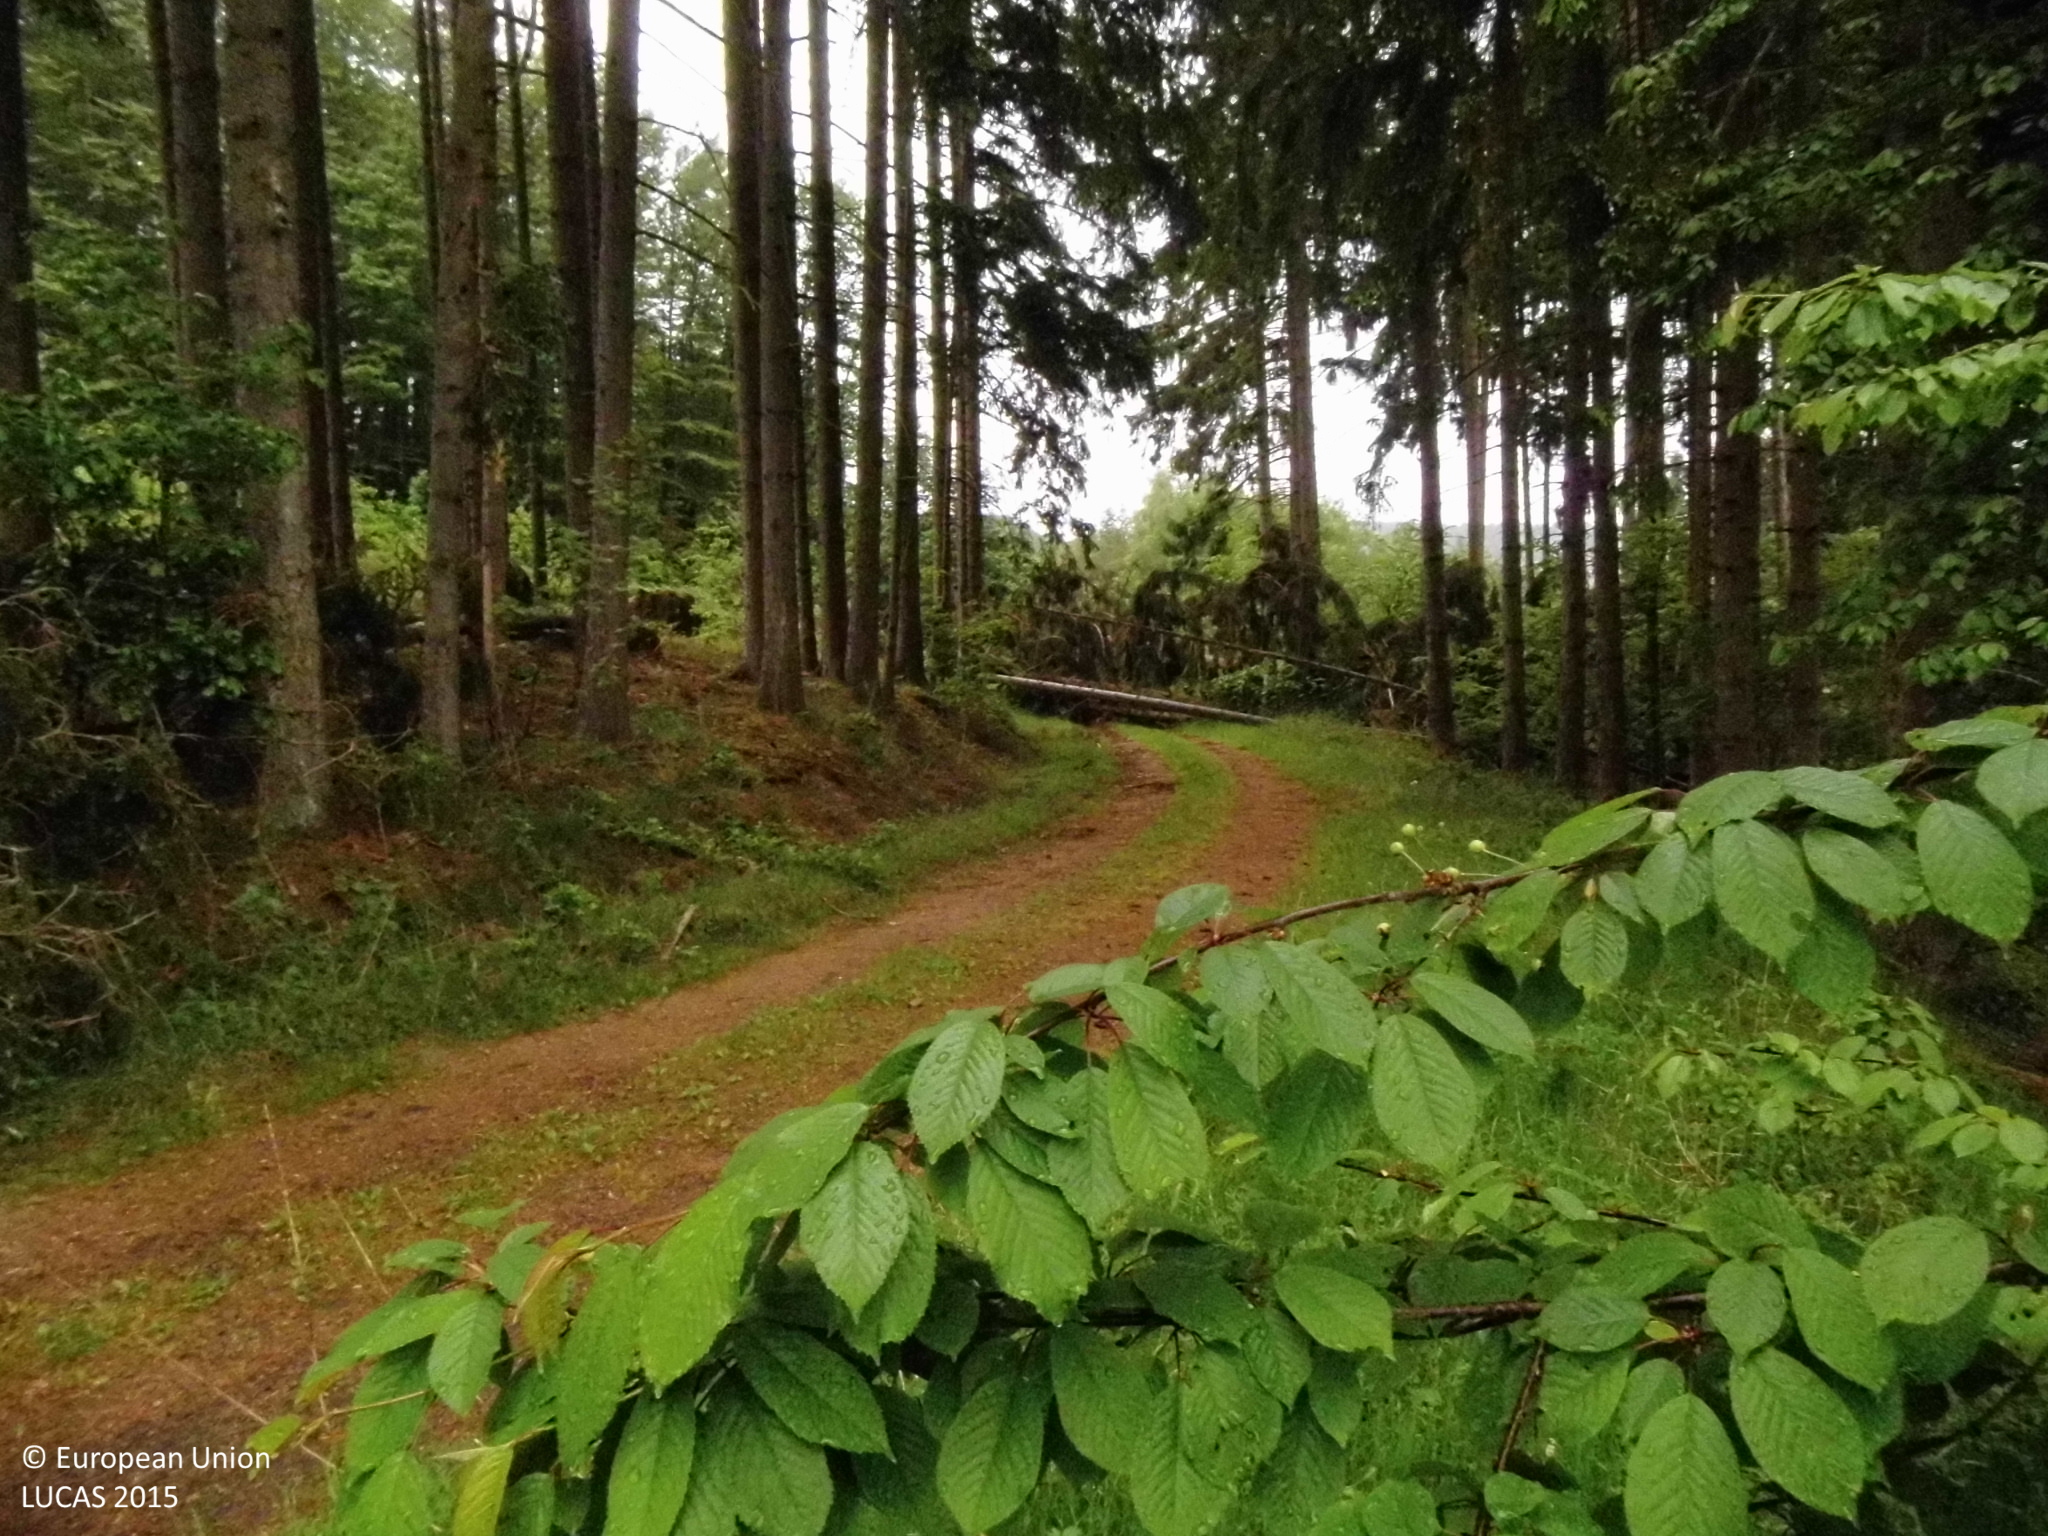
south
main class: Shrubland
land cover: Shrubland with sparse tree cover
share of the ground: > 75 %
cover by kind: herbaceous plants 55 %, shrubs 40 %, broadleaved forest trees 5 %
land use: Semi-natural and natural areas not in use
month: May
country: DE
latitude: 50.6072
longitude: 7.5274
